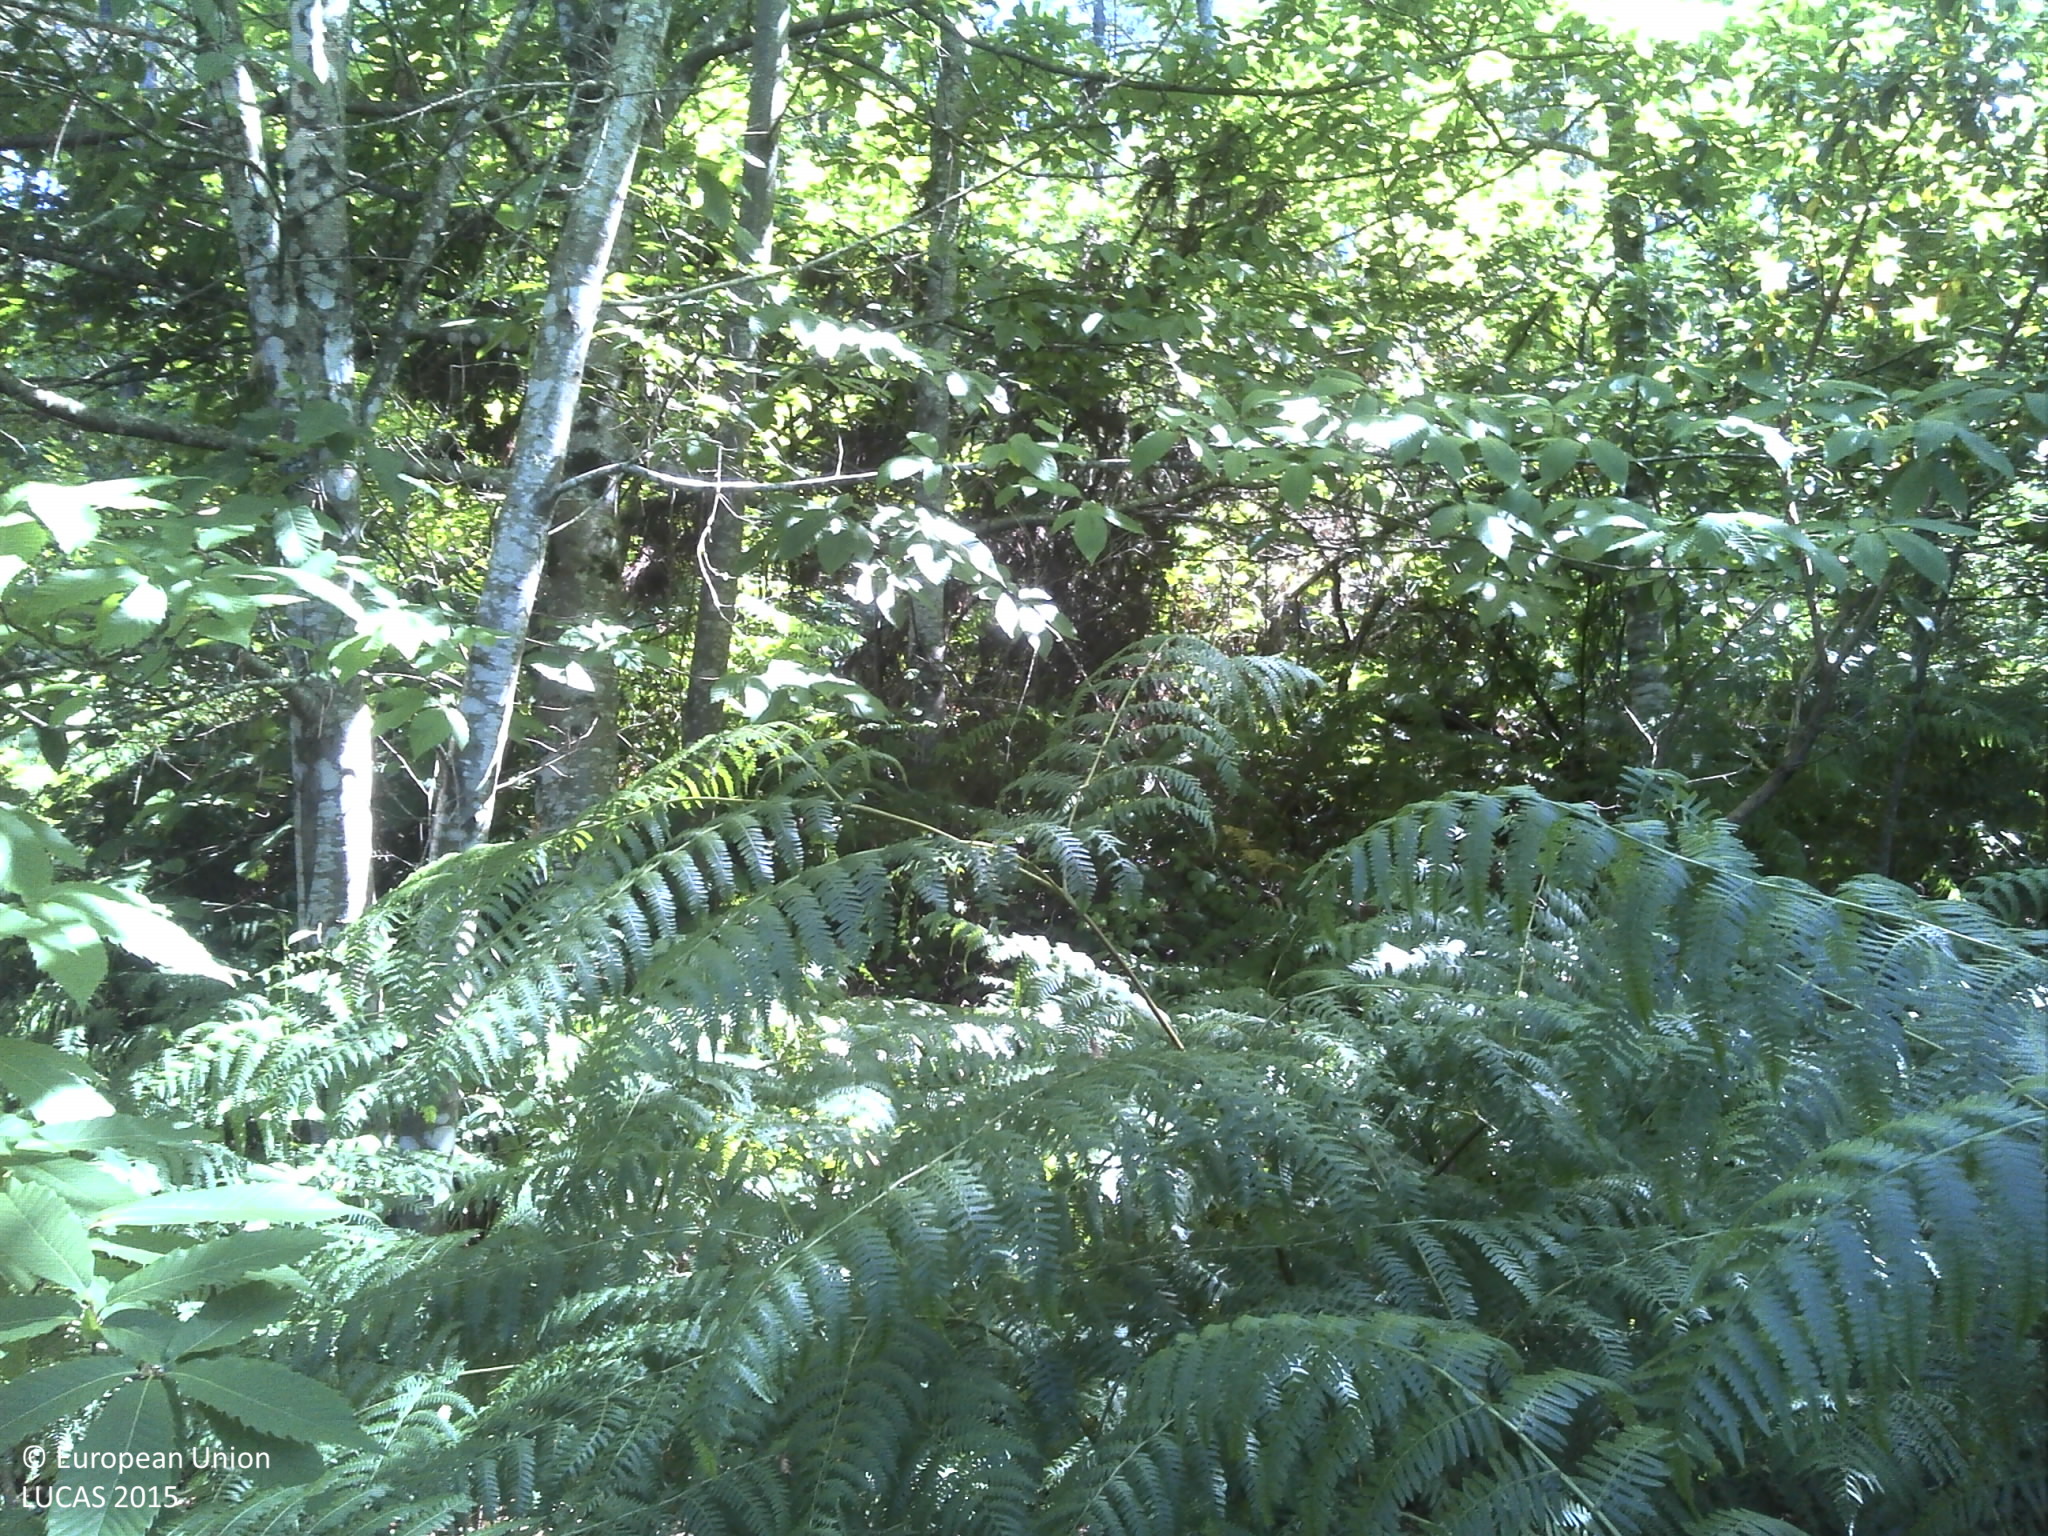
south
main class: Woodland
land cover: Broadleaved woodland
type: thermophilous deciduous forest
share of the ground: 50 - 75 %
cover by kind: broadleaved forest trees 70 %, shrubs 20 %, herbaceous plants 5 %, unconsolidated bare surface 5 %
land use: Forestry
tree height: > 5 m
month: July
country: PT
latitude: 40.2887
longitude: -7.8912
